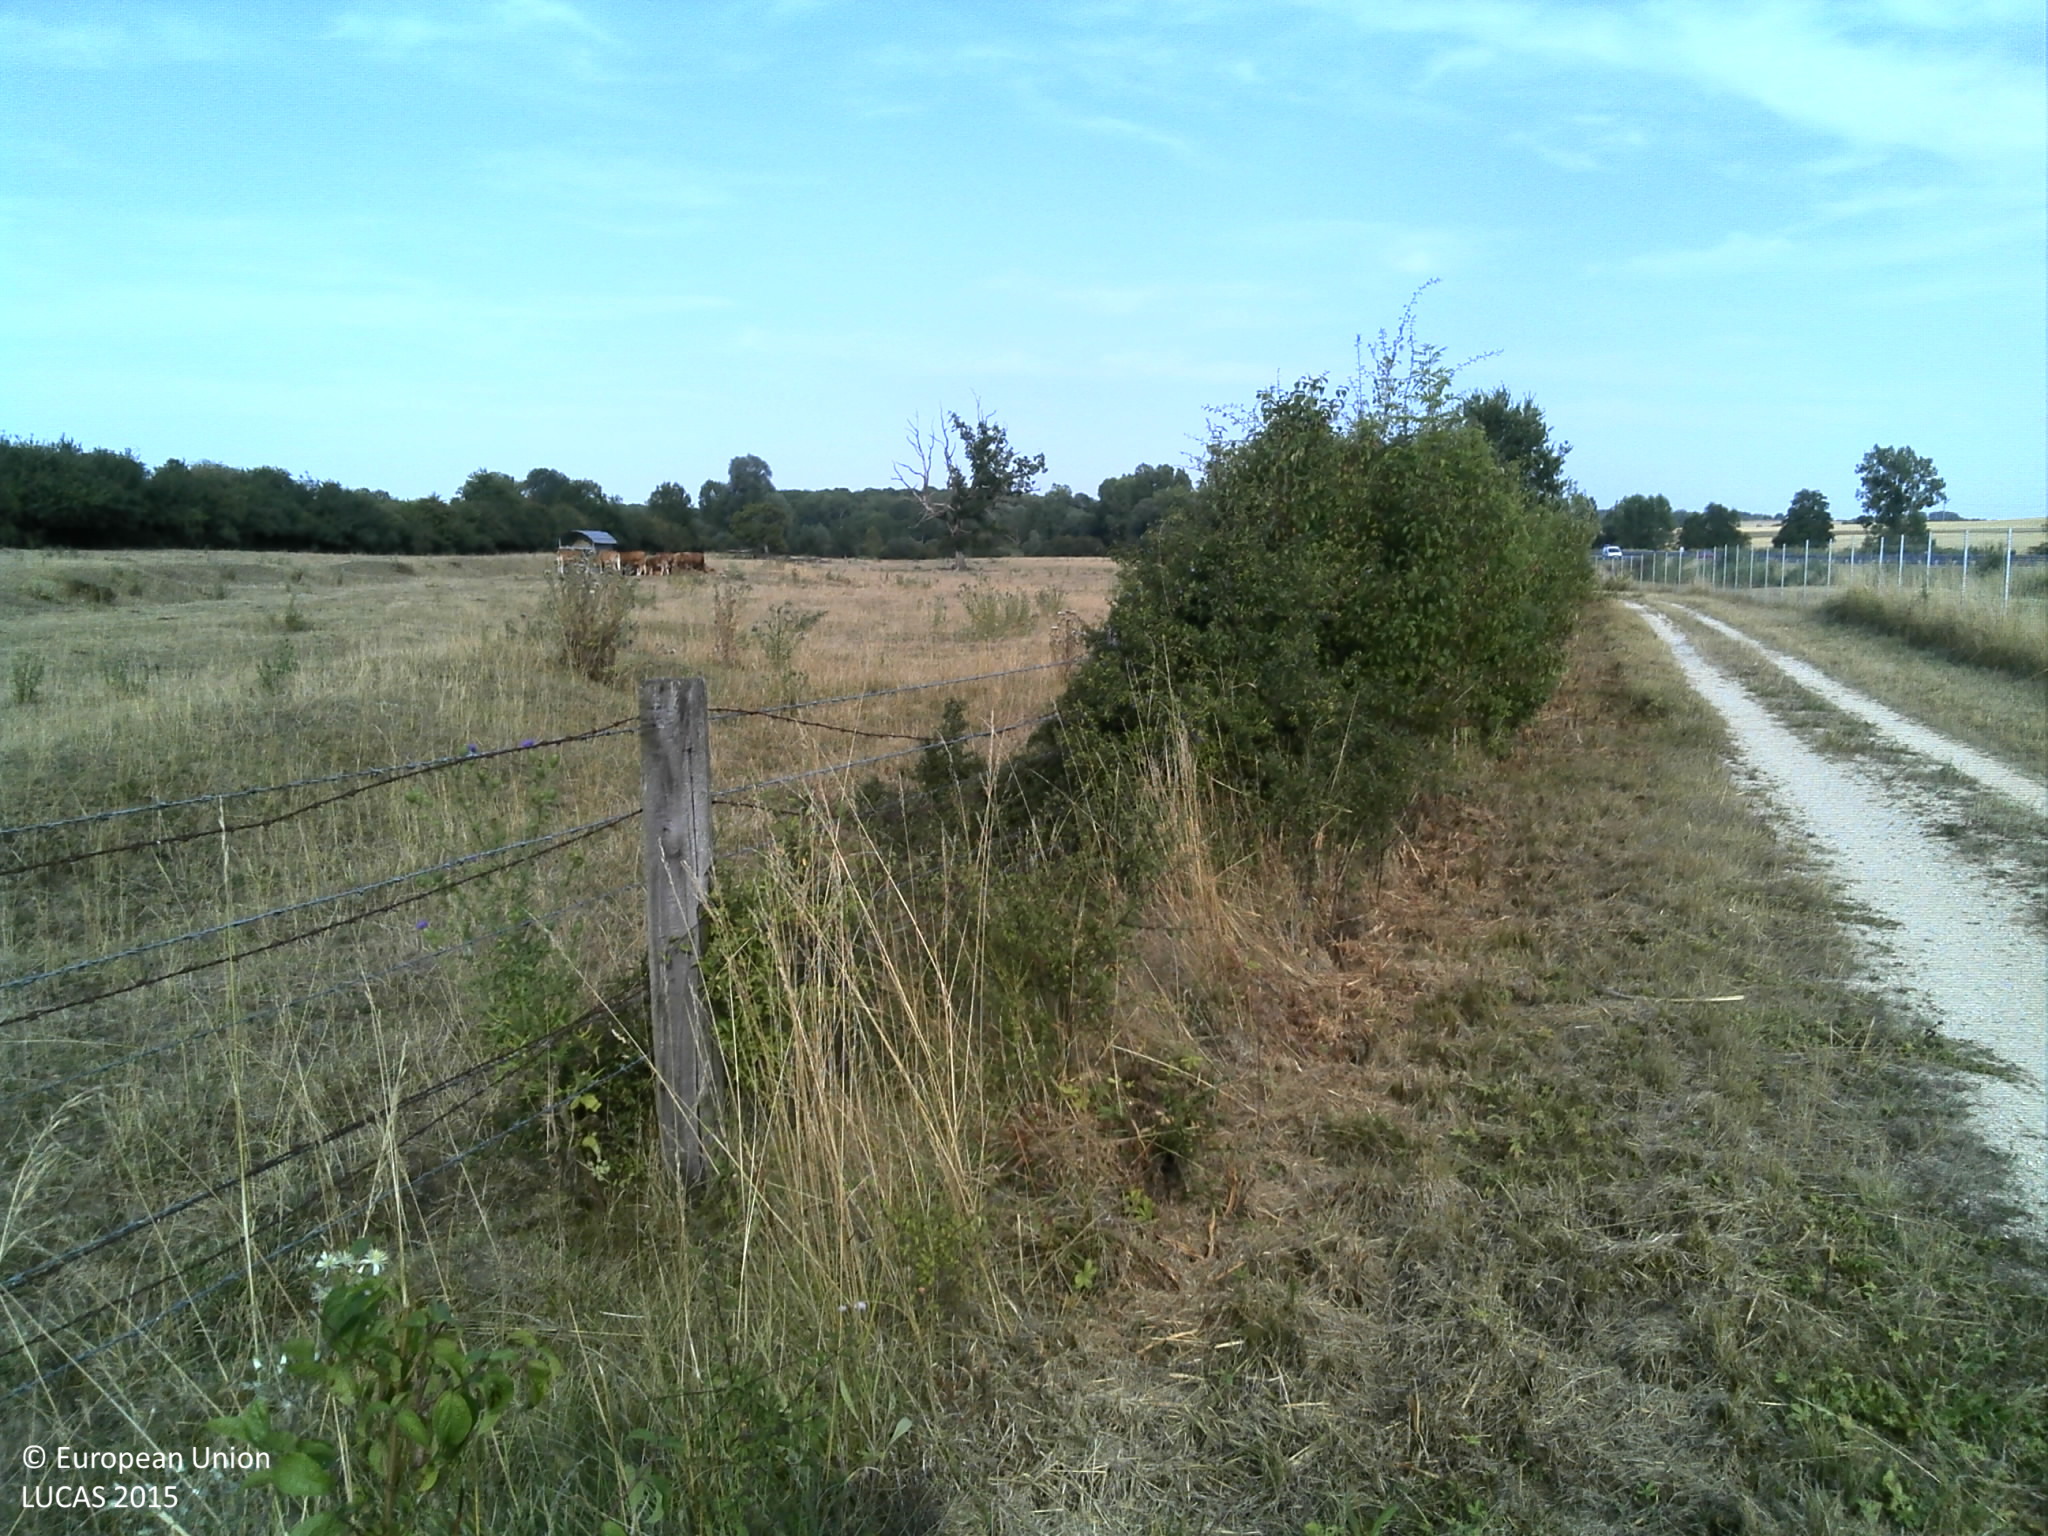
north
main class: Grassland
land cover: Grassland without tree/shrub cover
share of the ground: > 75 %
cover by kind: herbaceous plants 95 %, shrubs 5 %
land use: Agriculture (excluding fallow land and kitchen gardens)
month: August
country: FR
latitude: 49.0761
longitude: 4.8364
